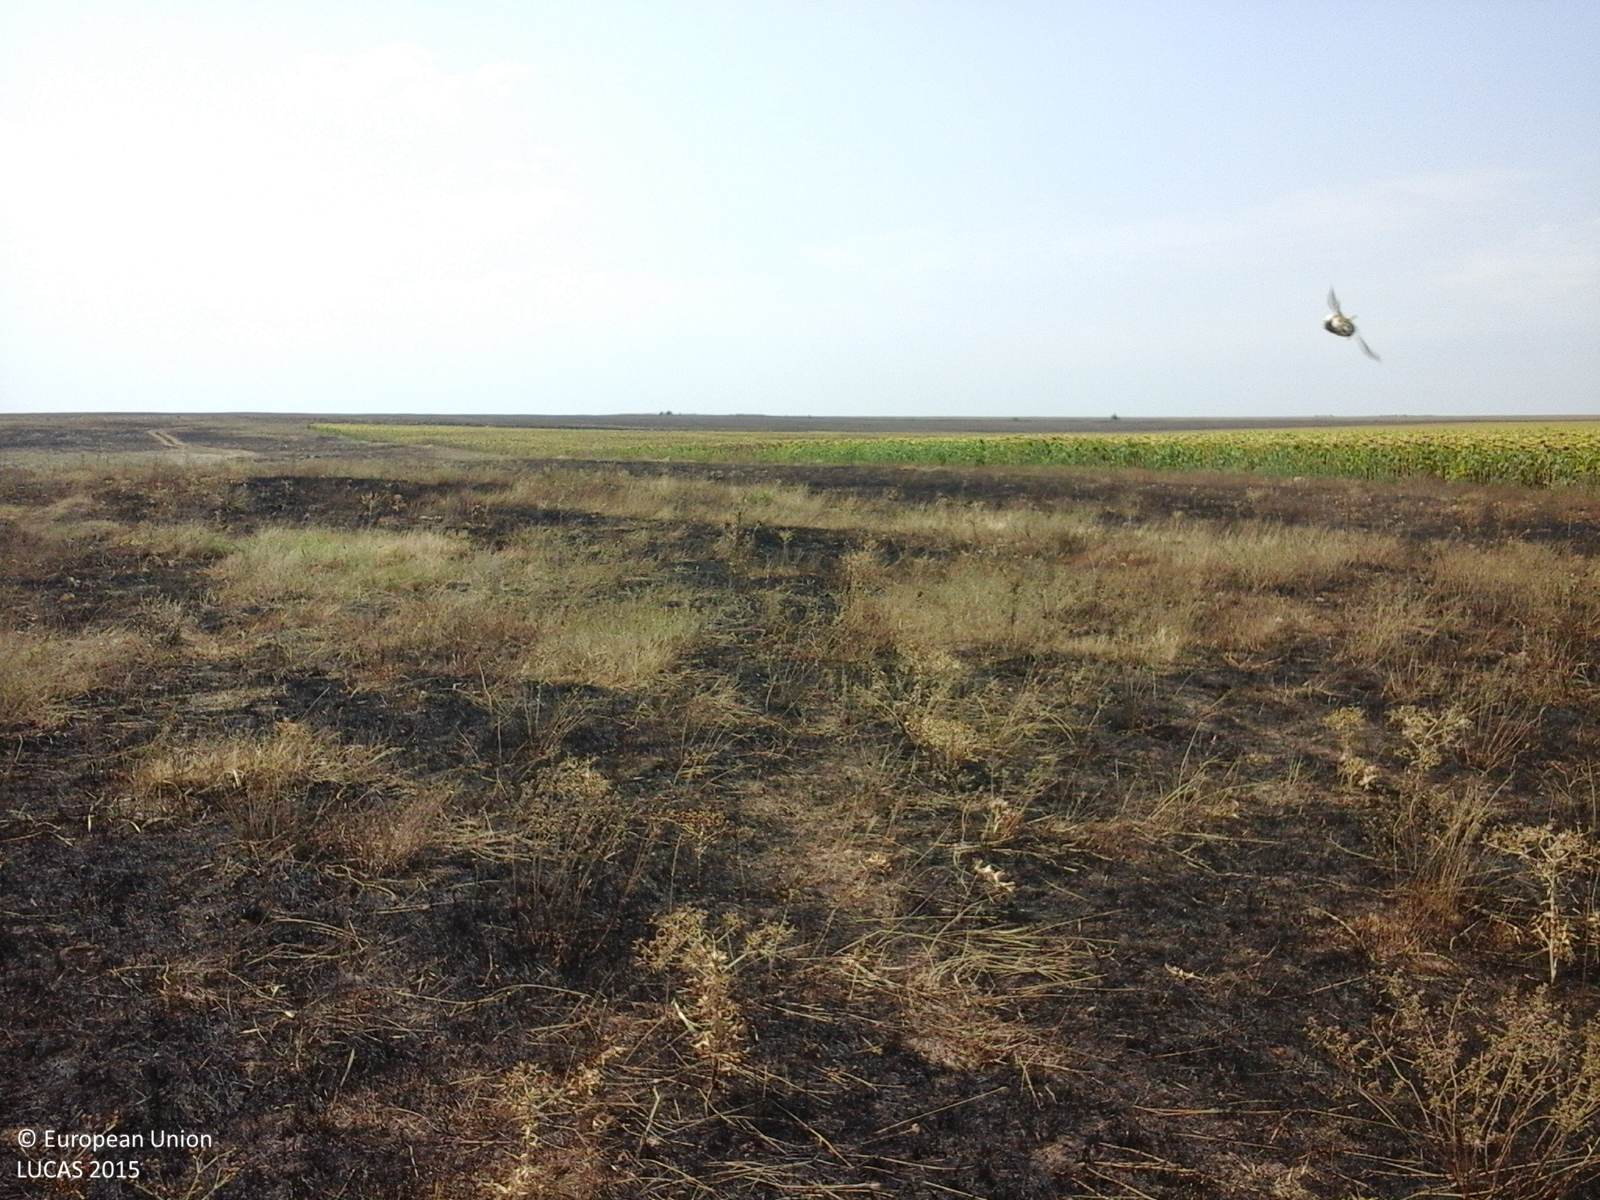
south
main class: Grassland
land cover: Spontaneously vegetated surfaces
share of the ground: > 75 %
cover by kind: herbaceous plants 70 %, consolidated bare surface 30 %
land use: Fallow land
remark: Burnt area
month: August
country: RO
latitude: 43.7660
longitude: 28.3585
